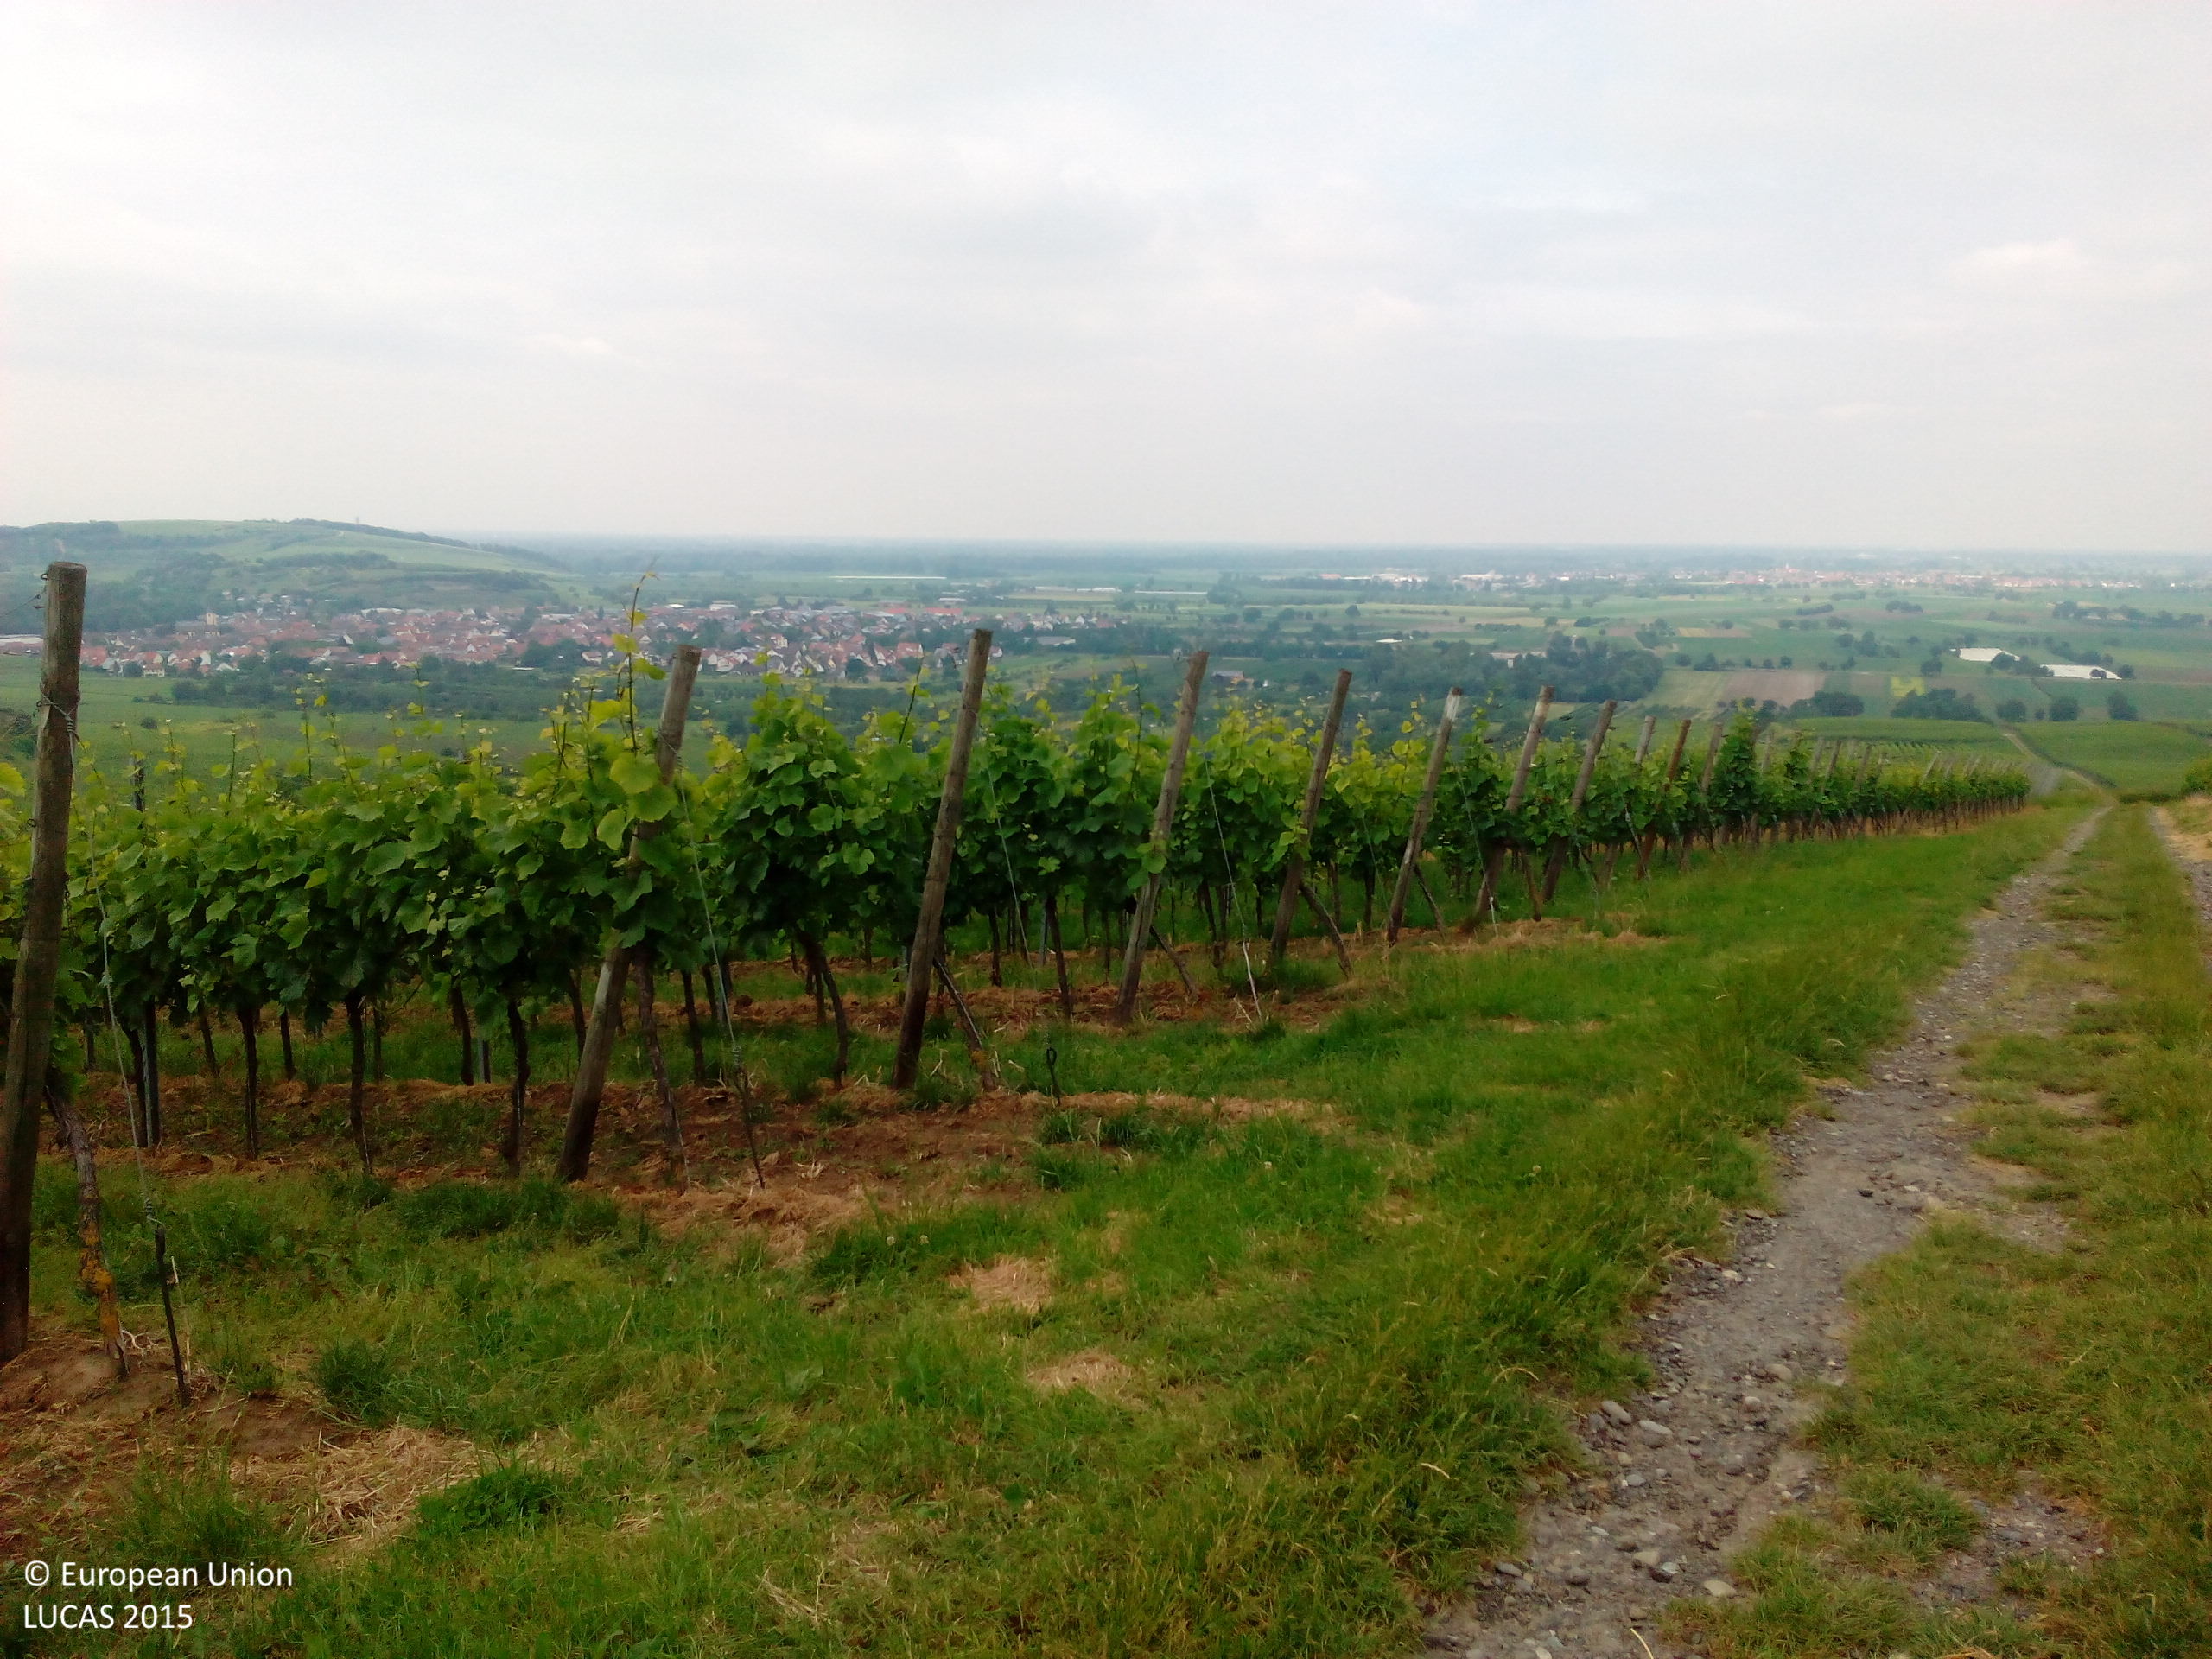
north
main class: Cropland
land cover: Vineyards
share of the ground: 25 - 50 %
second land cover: Grassland without tree/shrub cover
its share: 50 - 75 %
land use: Agriculture (excluding fallow land and kitchen gardens)
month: June
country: DE
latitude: 48.1259
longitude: 7.6231
